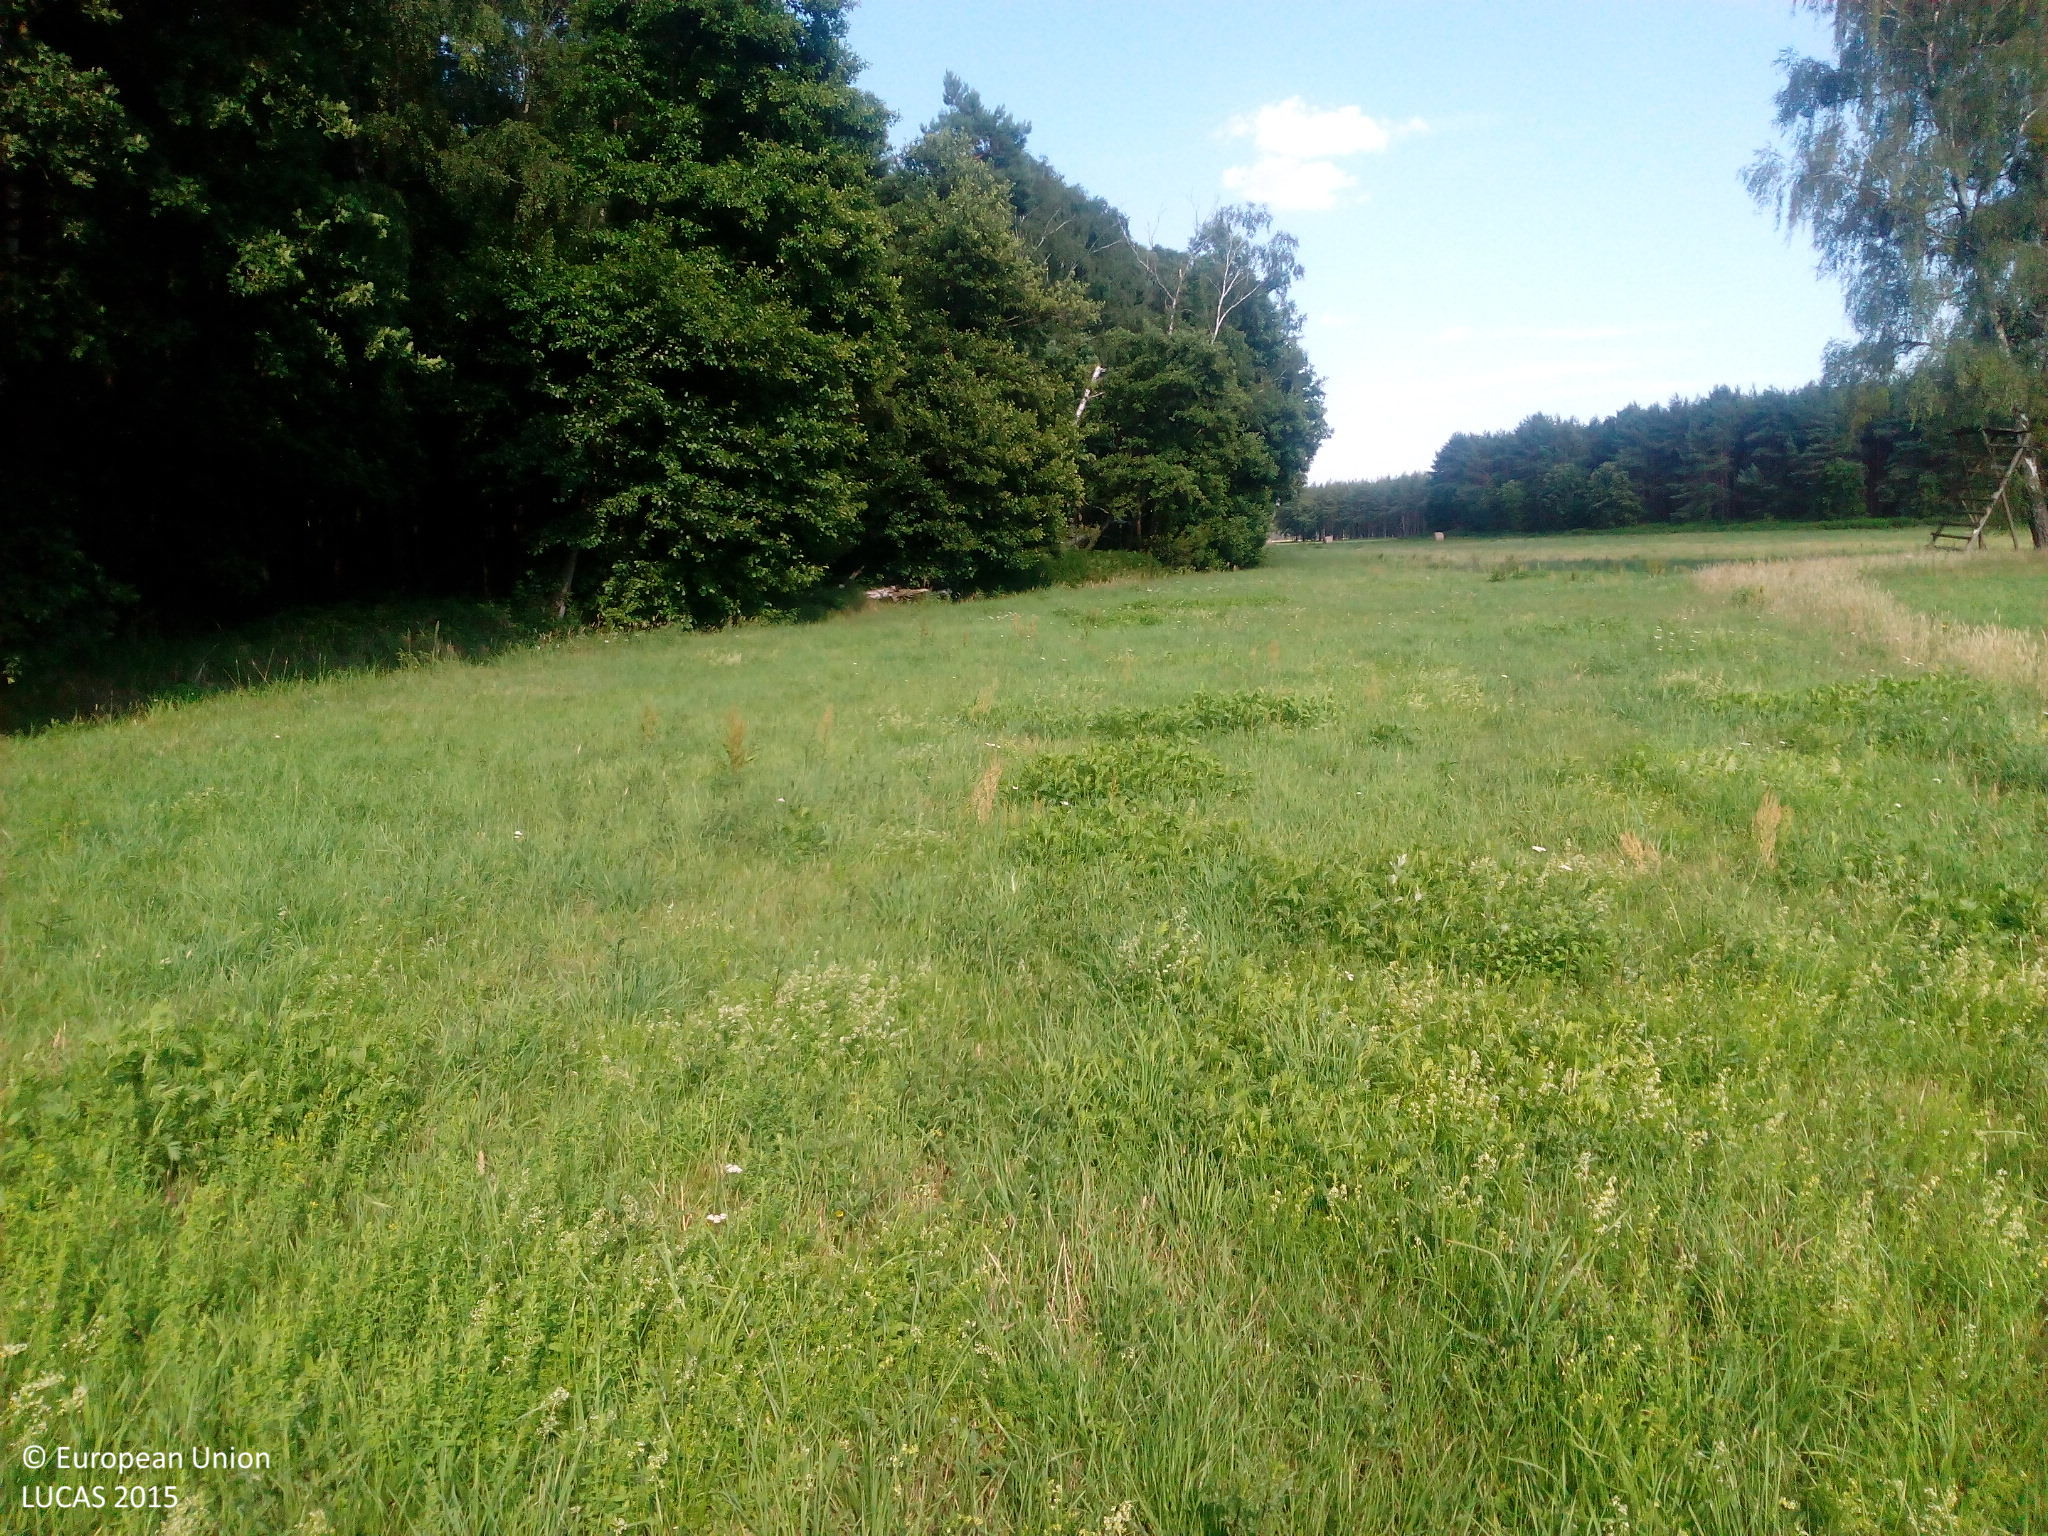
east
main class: Grassland
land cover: Grassland without tree/shrub cover
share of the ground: > 75 %
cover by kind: herbaceous plants 100 %
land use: Agriculture (excluding fallow land and kitchen gardens)
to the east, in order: Grassland without tree/shrub cover; Ditches and canals; Pine dominated mixed woodland; Pine dominated coniferous woodland
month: July
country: DE
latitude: 51.9576
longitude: 12.4008
